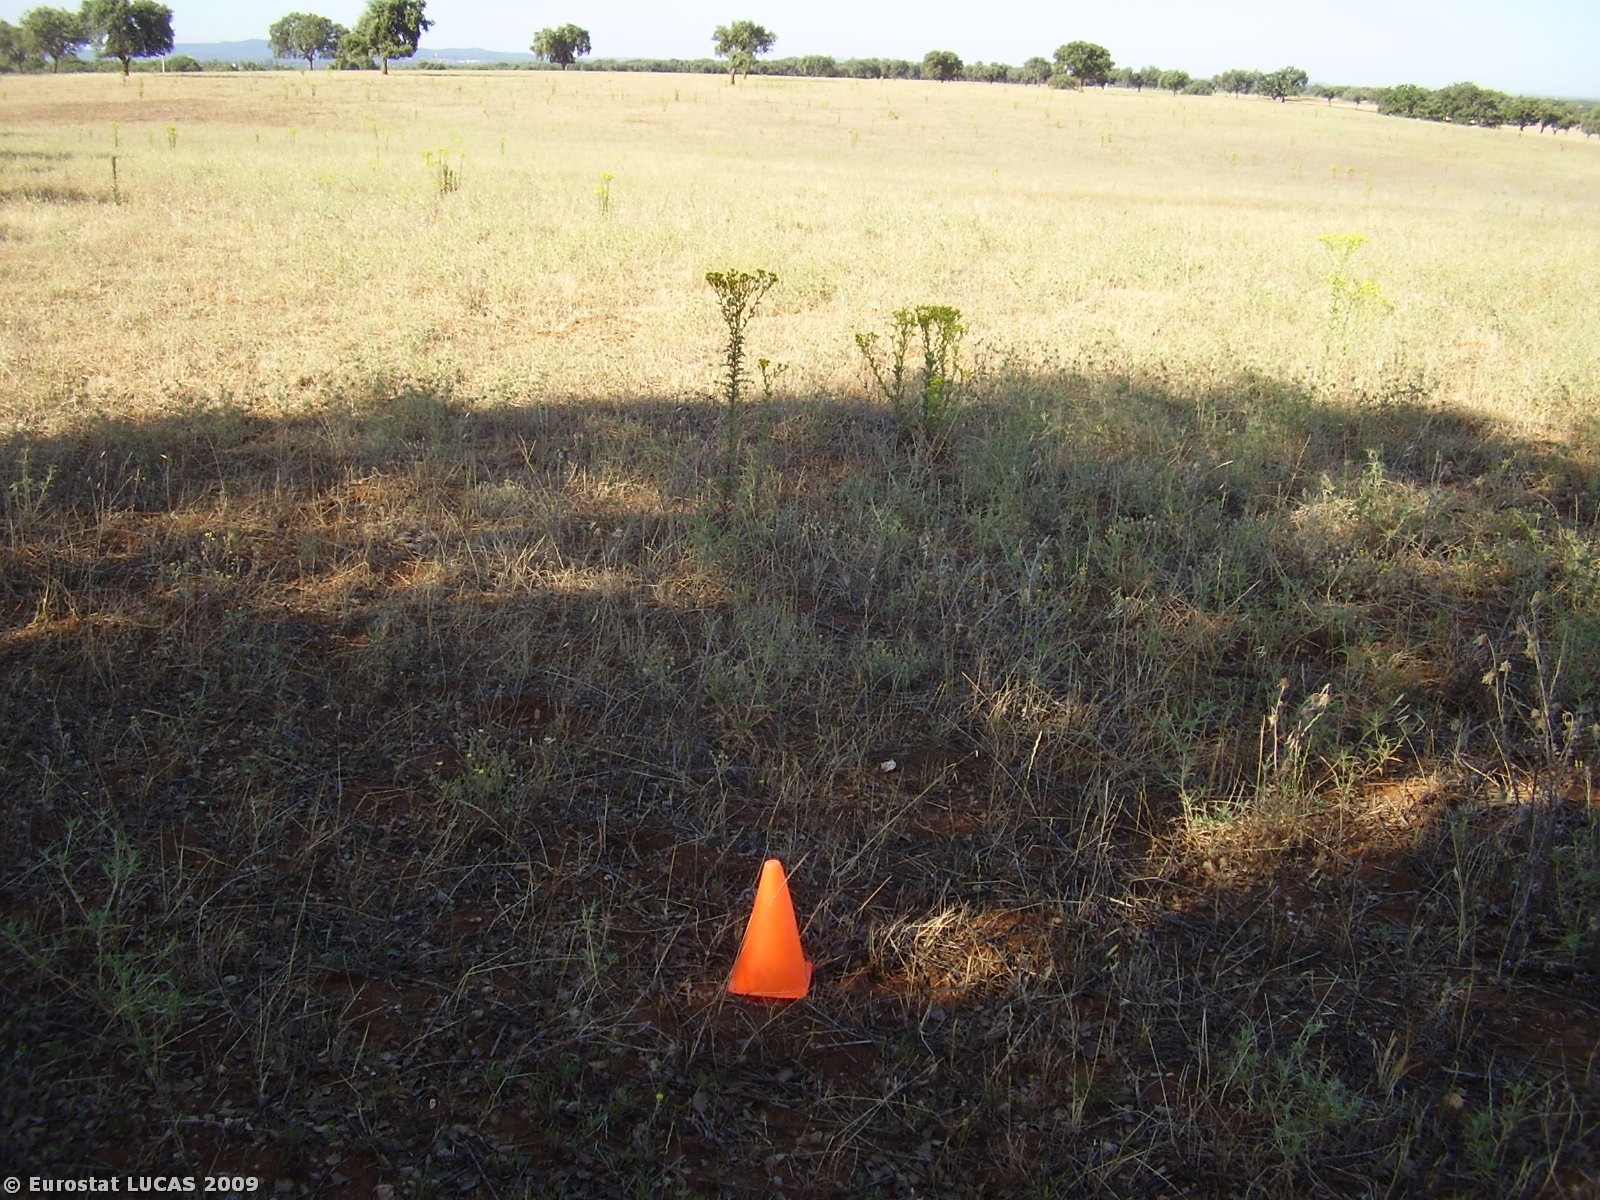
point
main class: Grassland
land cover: Grassland with sparse tree/shrub cover
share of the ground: > 75 %
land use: Fallow land
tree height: > 5 m
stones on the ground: 25 - 50 %
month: July
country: PT
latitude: 38.8772
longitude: -7.7347
